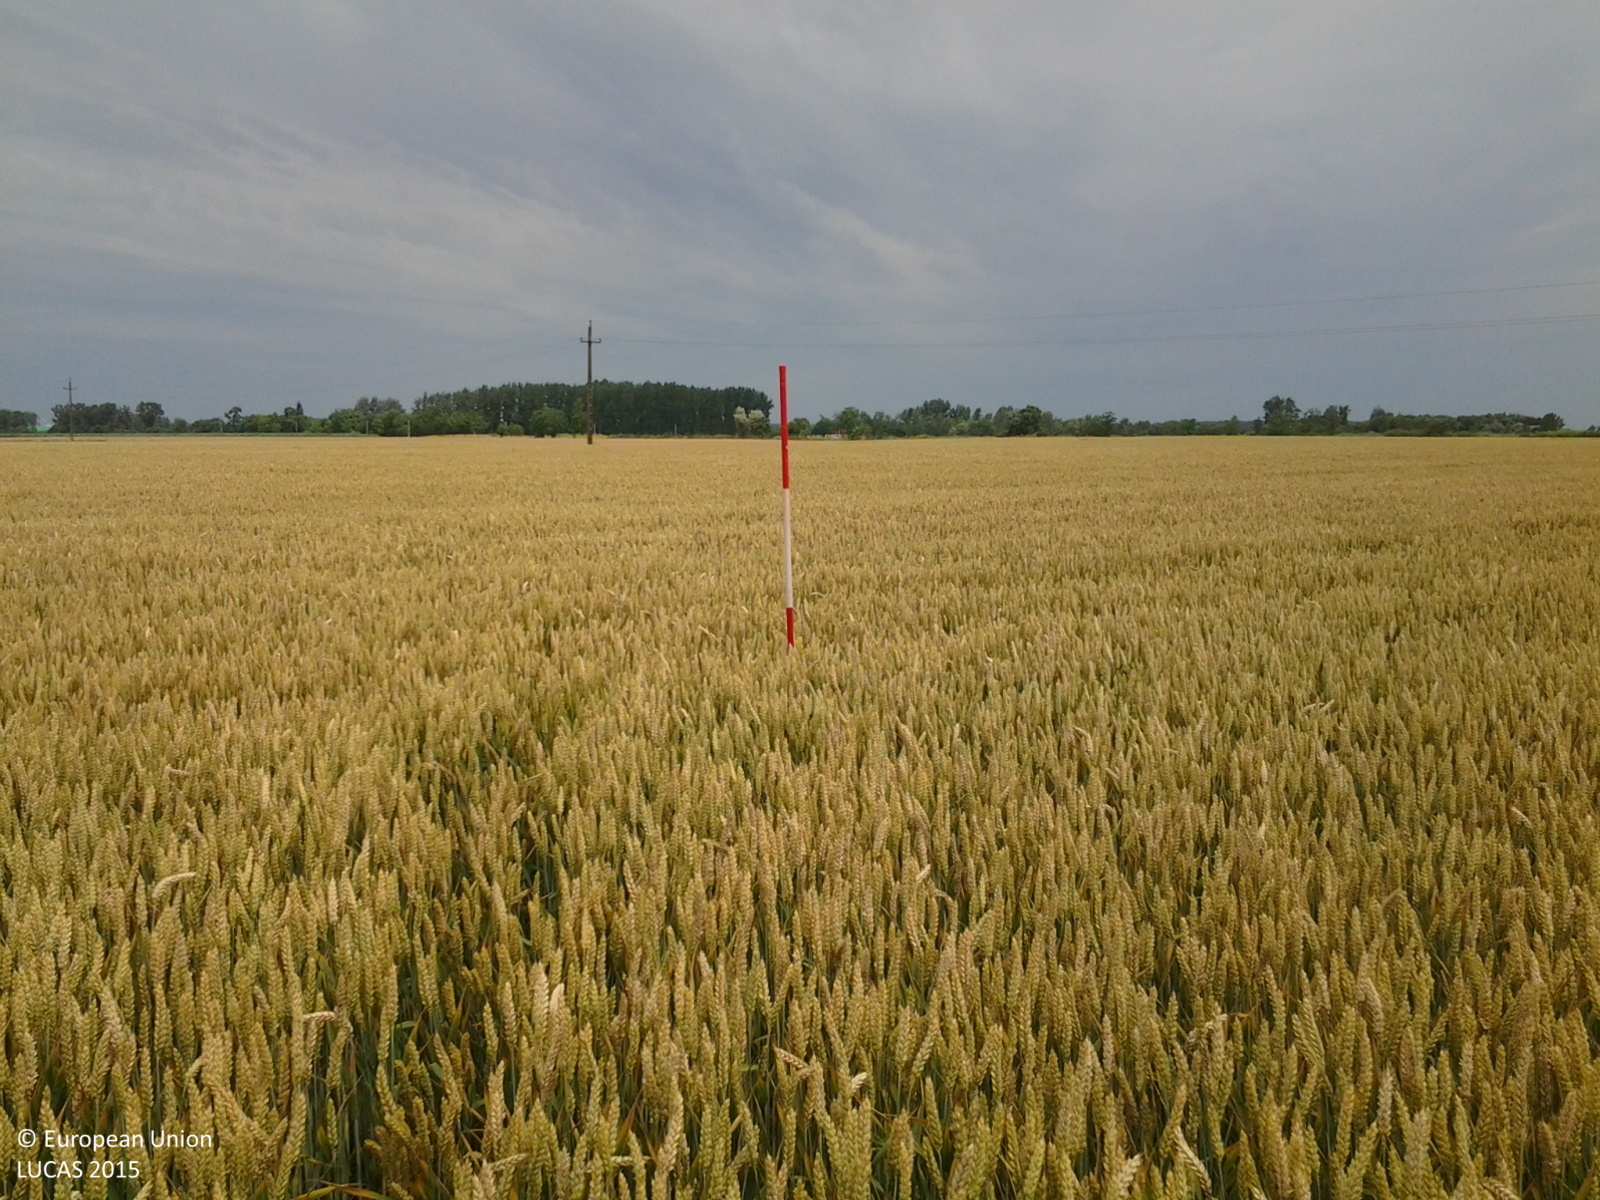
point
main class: Cropland
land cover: Common wheat
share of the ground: > 75 %
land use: Agriculture (excluding fallow land and kitchen gardens)
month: June
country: HU
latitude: 46.4402
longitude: 21.1358
